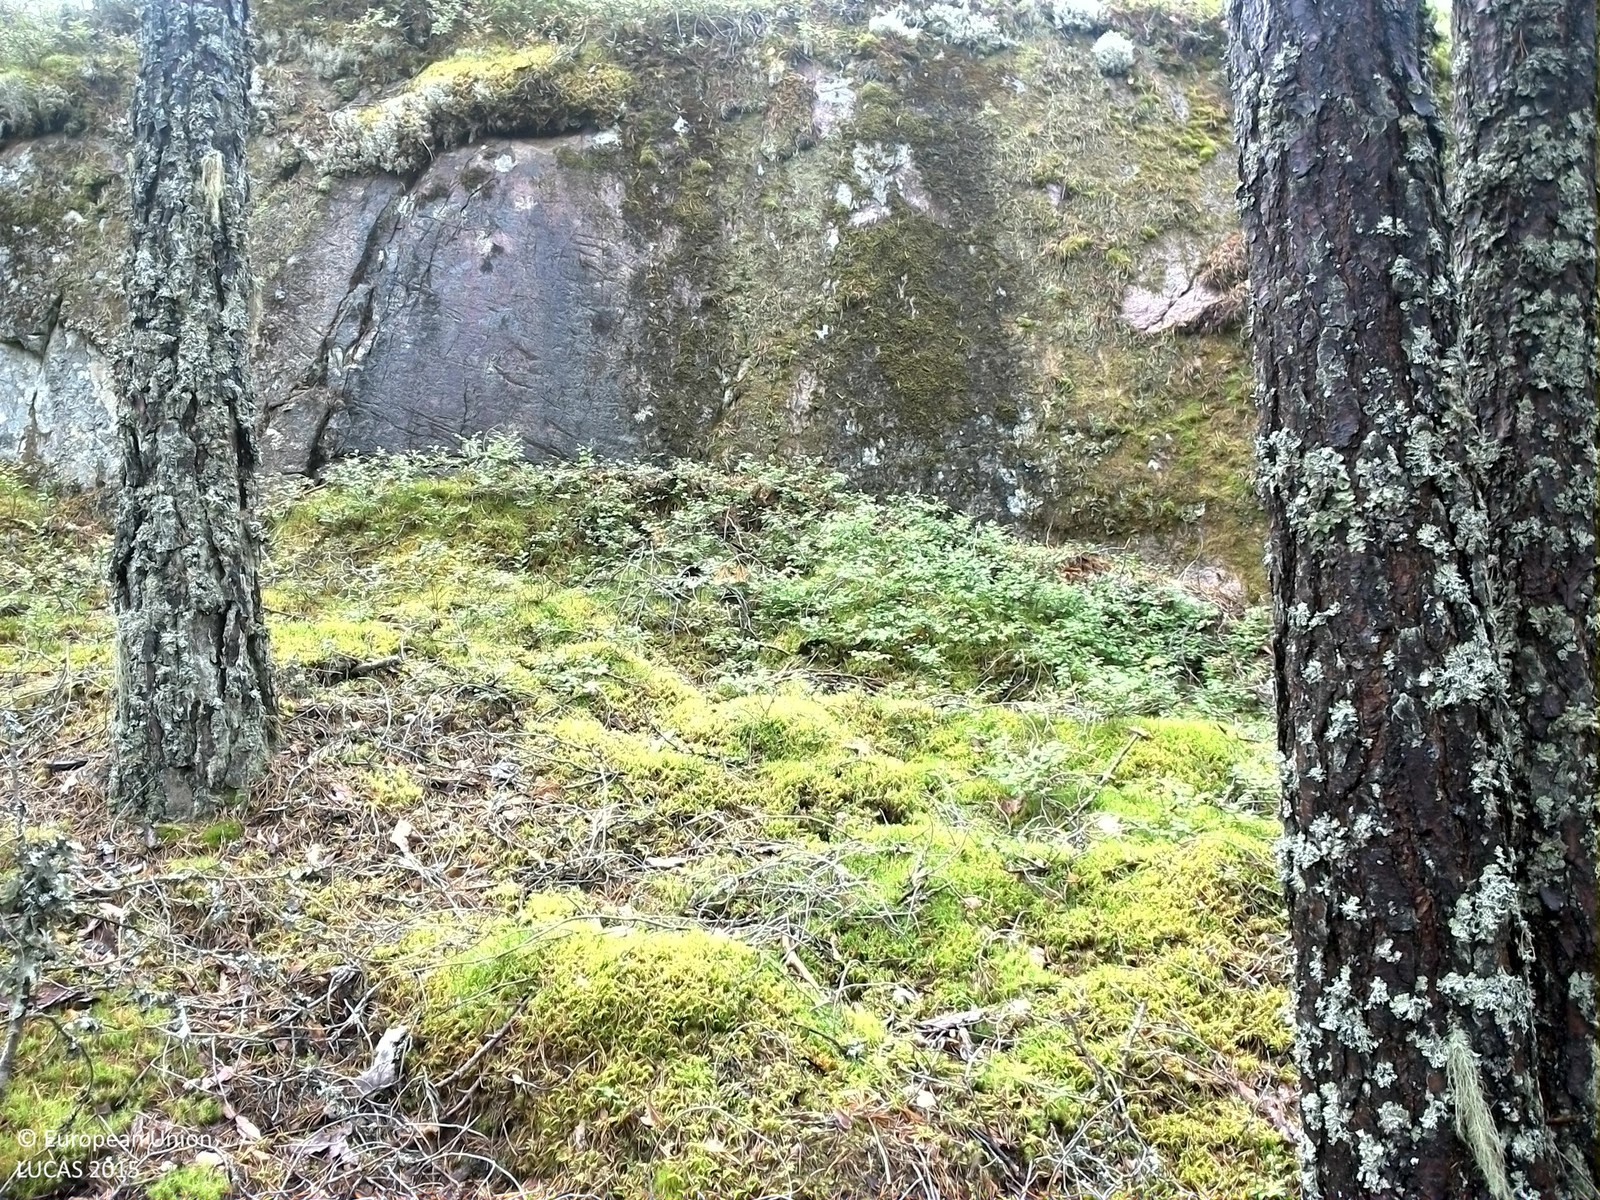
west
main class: Woodland
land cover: Pine dominated coniferous woodland
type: boreal forest
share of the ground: 50 - 75 %
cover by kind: coniferous forest trees 65 %, shrubs 20 %, lichens and mosses 10 %, broadleaved forest trees 5 %
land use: Forestry
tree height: > 5 m
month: September
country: SE
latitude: 59.3021
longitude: 12.0145
